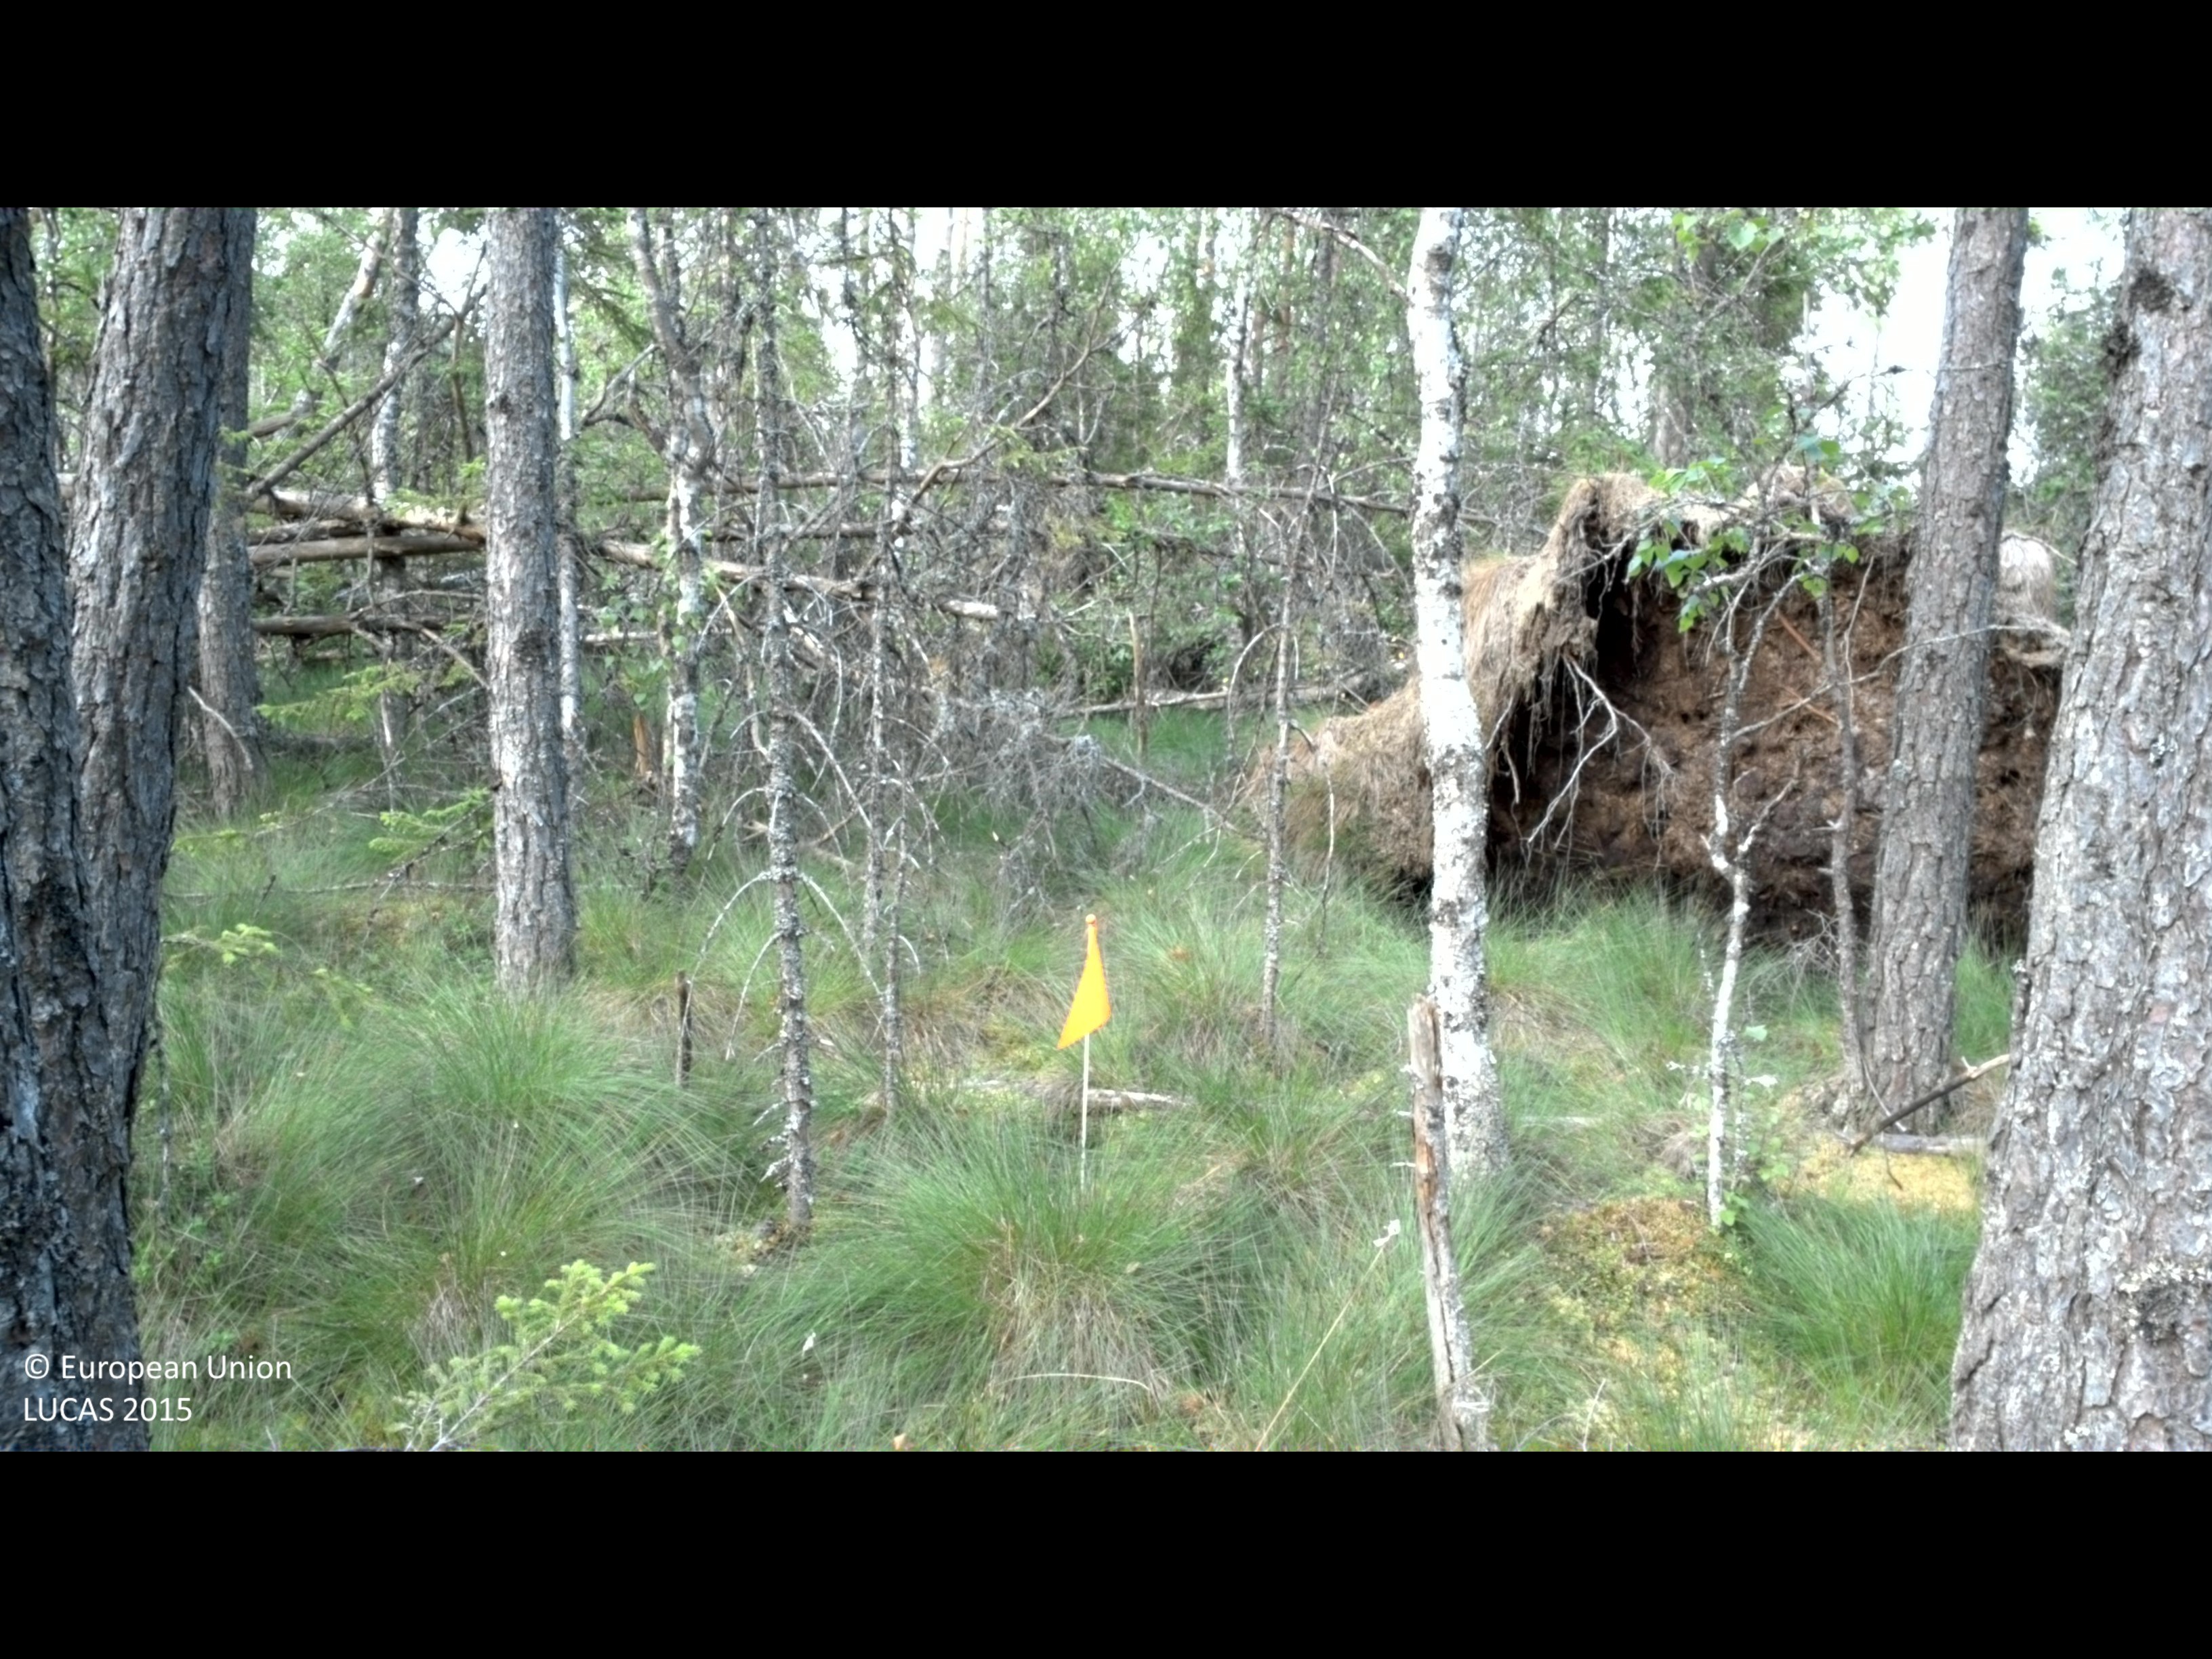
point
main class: Woodland
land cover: Pine dominated mixed woodland
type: mire and swamp forests
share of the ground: 50 - 75 %
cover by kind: broadleaved forest trees 35 %, herbaceous plants 35 %, coniferous forest trees 30 %
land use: Semi-natural and natural areas not in use
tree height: > 5 m
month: August
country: SE
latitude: 56.7355
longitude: 14.0671
